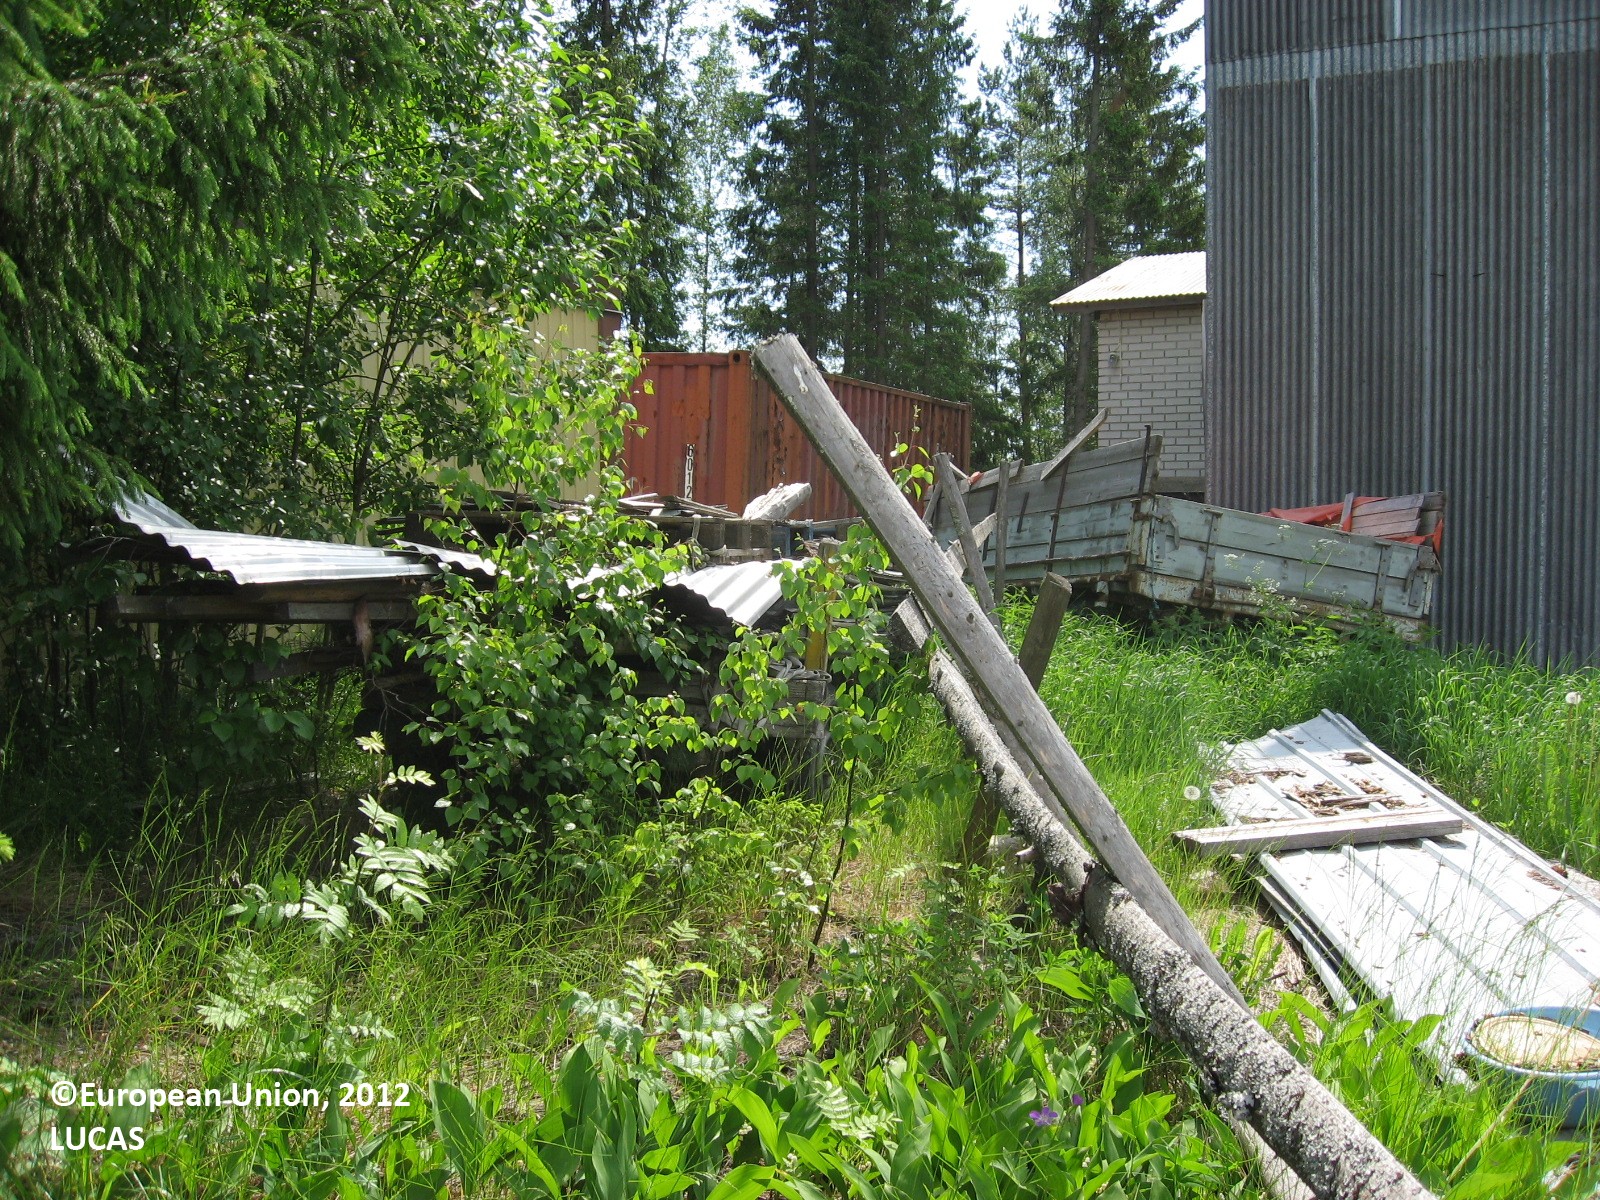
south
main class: Grassland
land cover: Grassland with sparse tree/shrub cover
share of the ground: > 75 %
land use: Residential
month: June
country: FI
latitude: 60.5220
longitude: 25.4118
